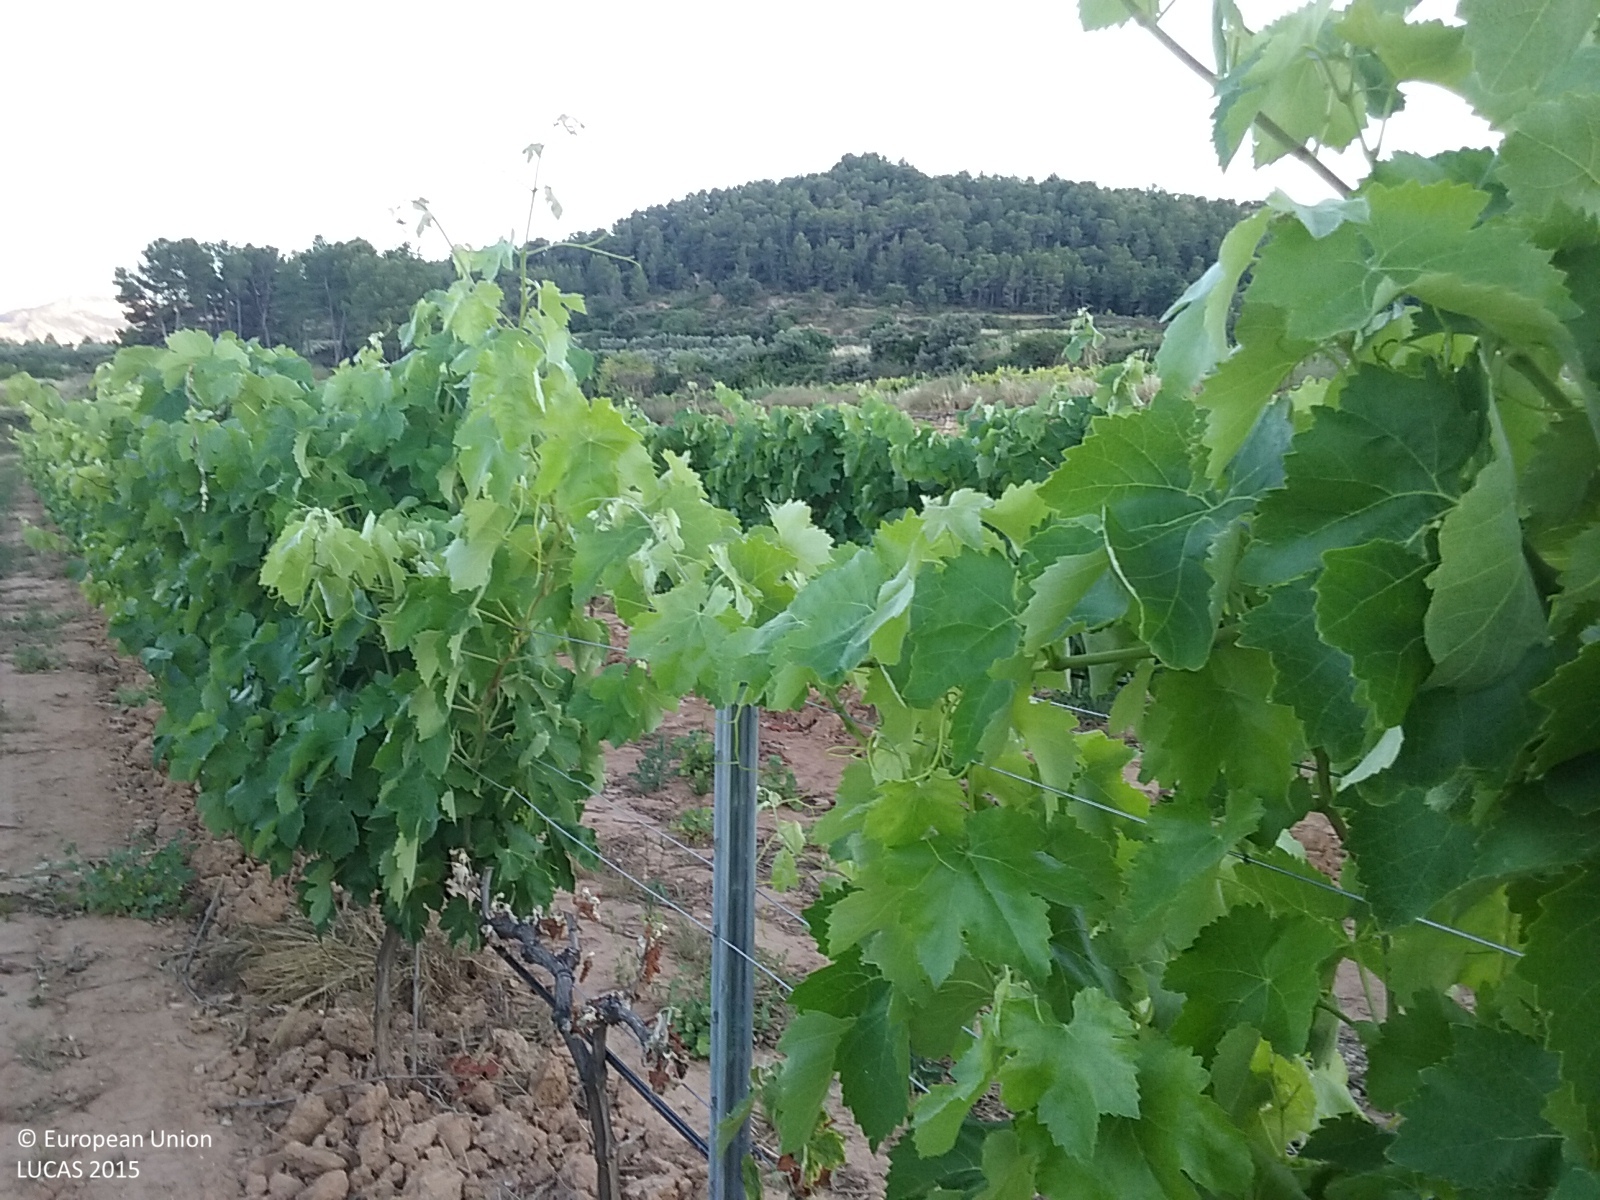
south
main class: Cropland
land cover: Vineyards
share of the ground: 10 - 25 %
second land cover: Spontaneously vegetated surfaces
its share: 10 - 25 %
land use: Agriculture (excluding fallow land and kitchen gardens)
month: June
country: ES
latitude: 41.0100
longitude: 0.3484
